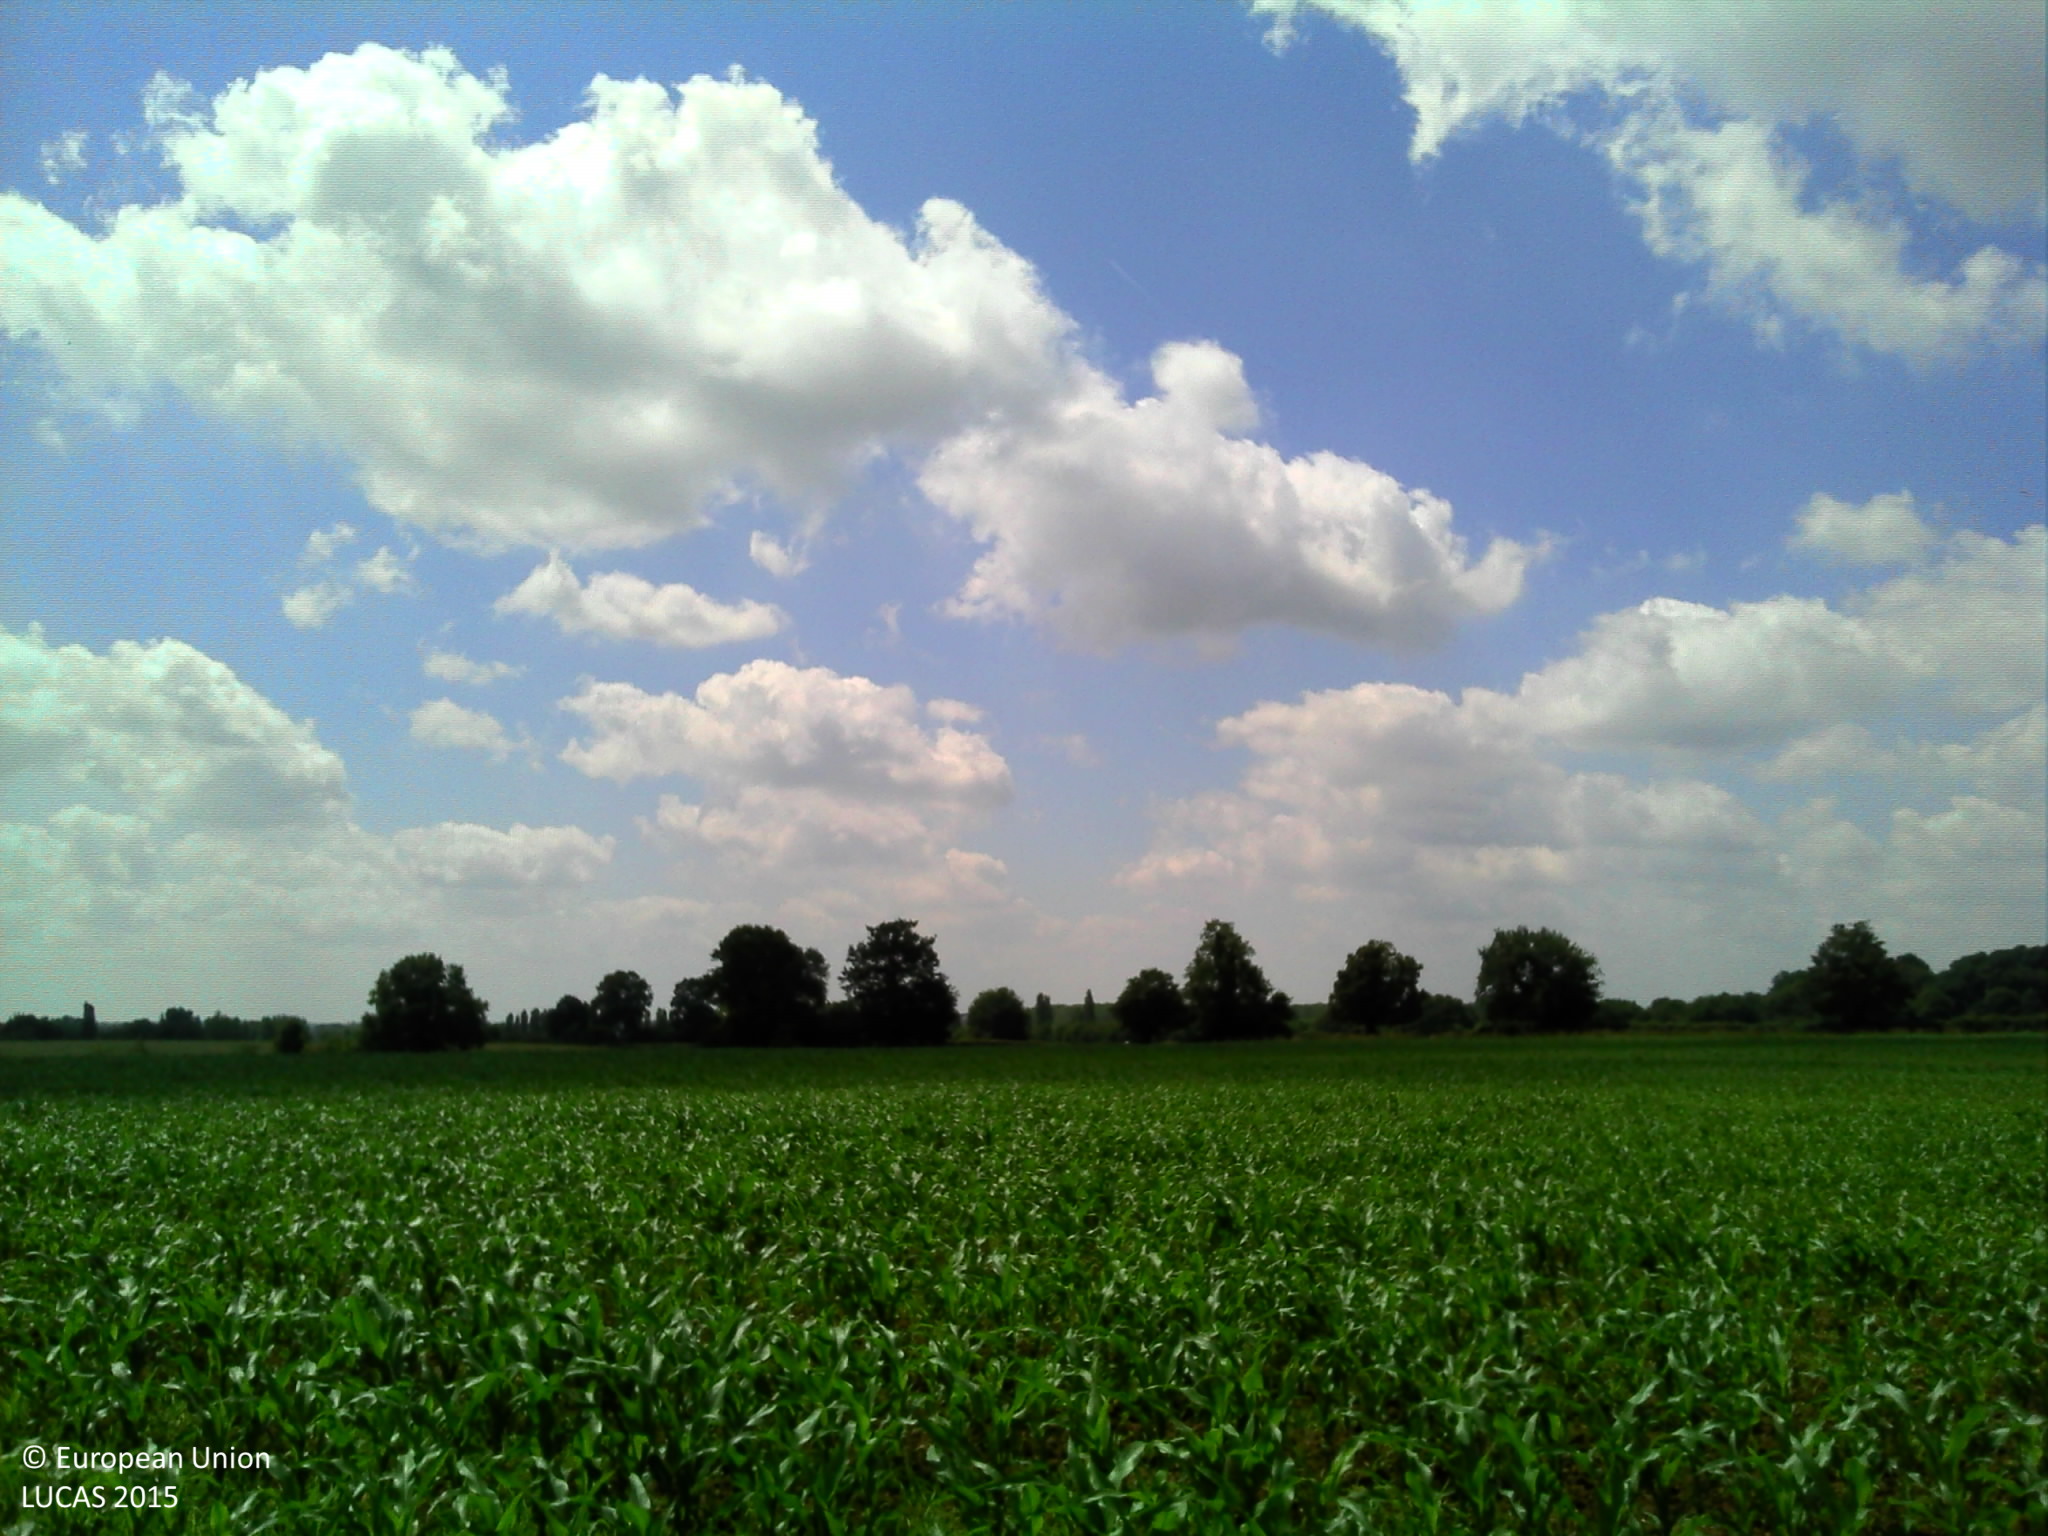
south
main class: Cropland
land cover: Maize
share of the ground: 25 - 50 %
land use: Agriculture (excluding fallow land and kitchen gardens)
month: June
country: FR
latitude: 48.2091
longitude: 0.2715
